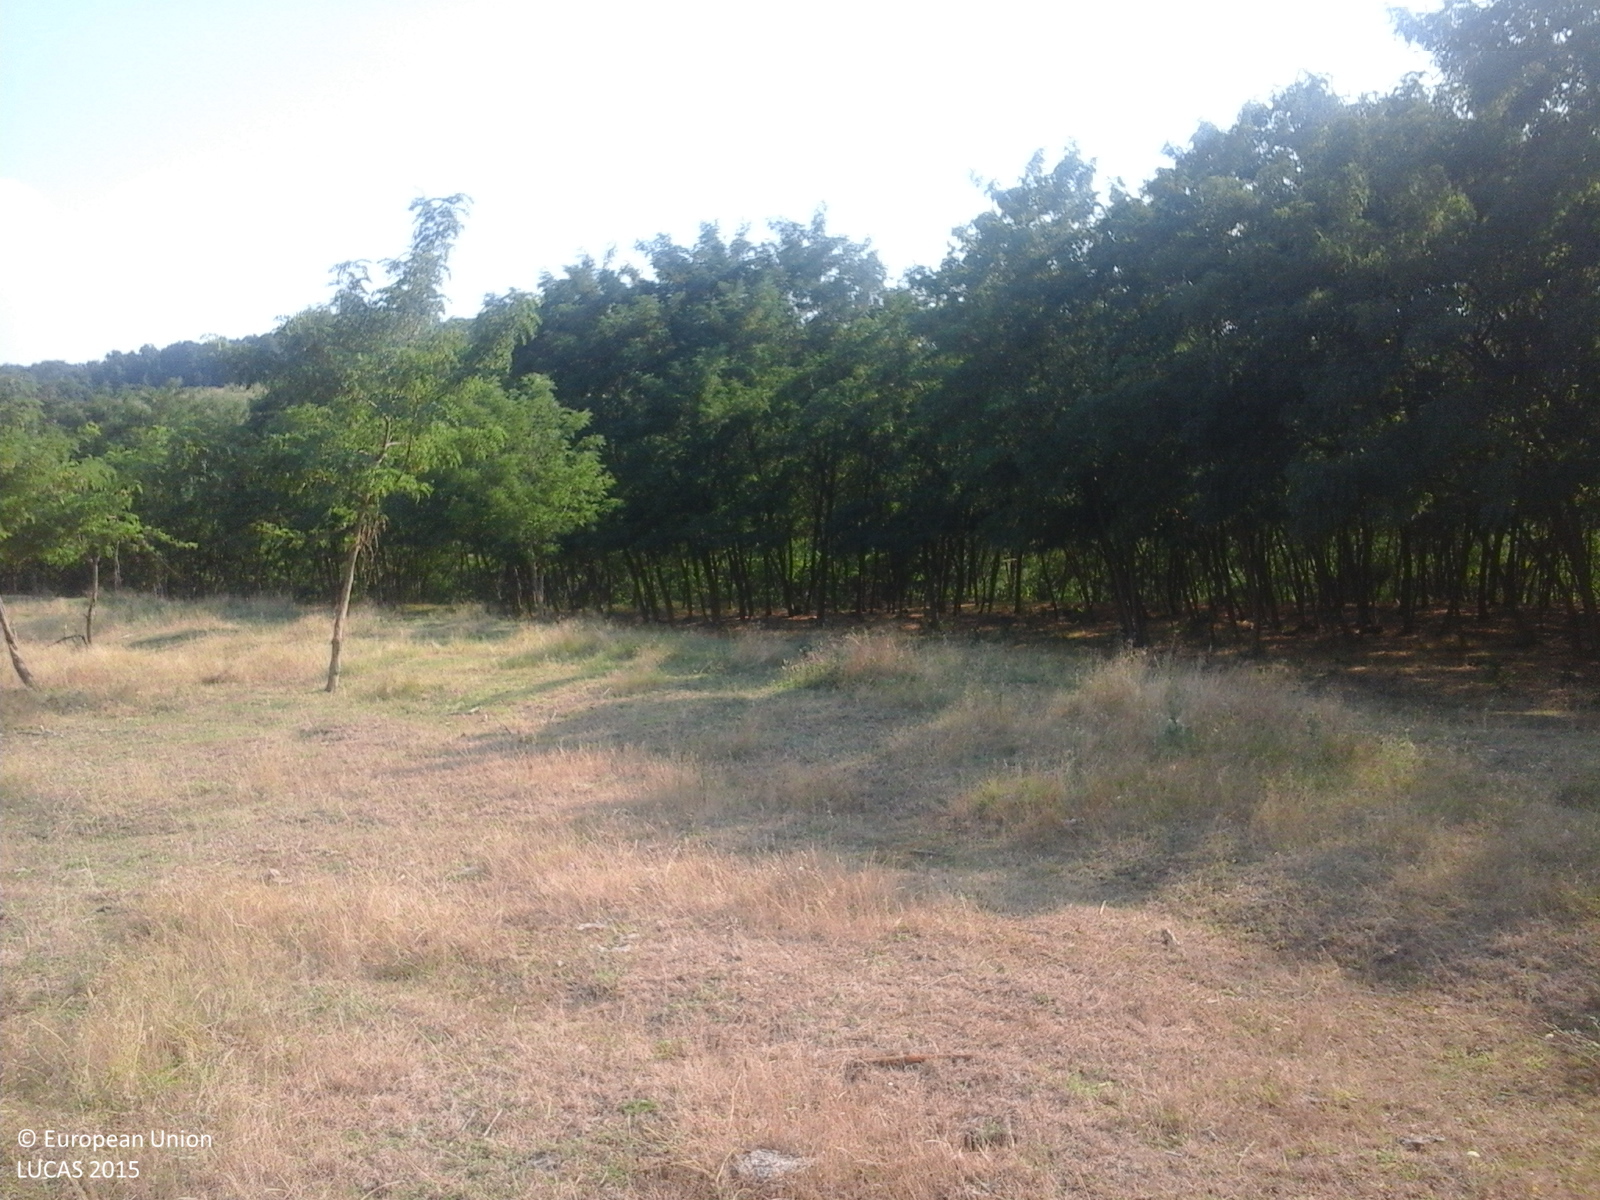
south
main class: Grassland
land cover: Grassland with sparse tree/shrub cover
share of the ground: > 75 %
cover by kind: herbaceous plants 95 %, broadleaved forest trees 5 %
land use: Agriculture (excluding fallow land and kitchen gardens)
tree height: > 5 m
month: July
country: RO
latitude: 46.1002
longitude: 27.7733
